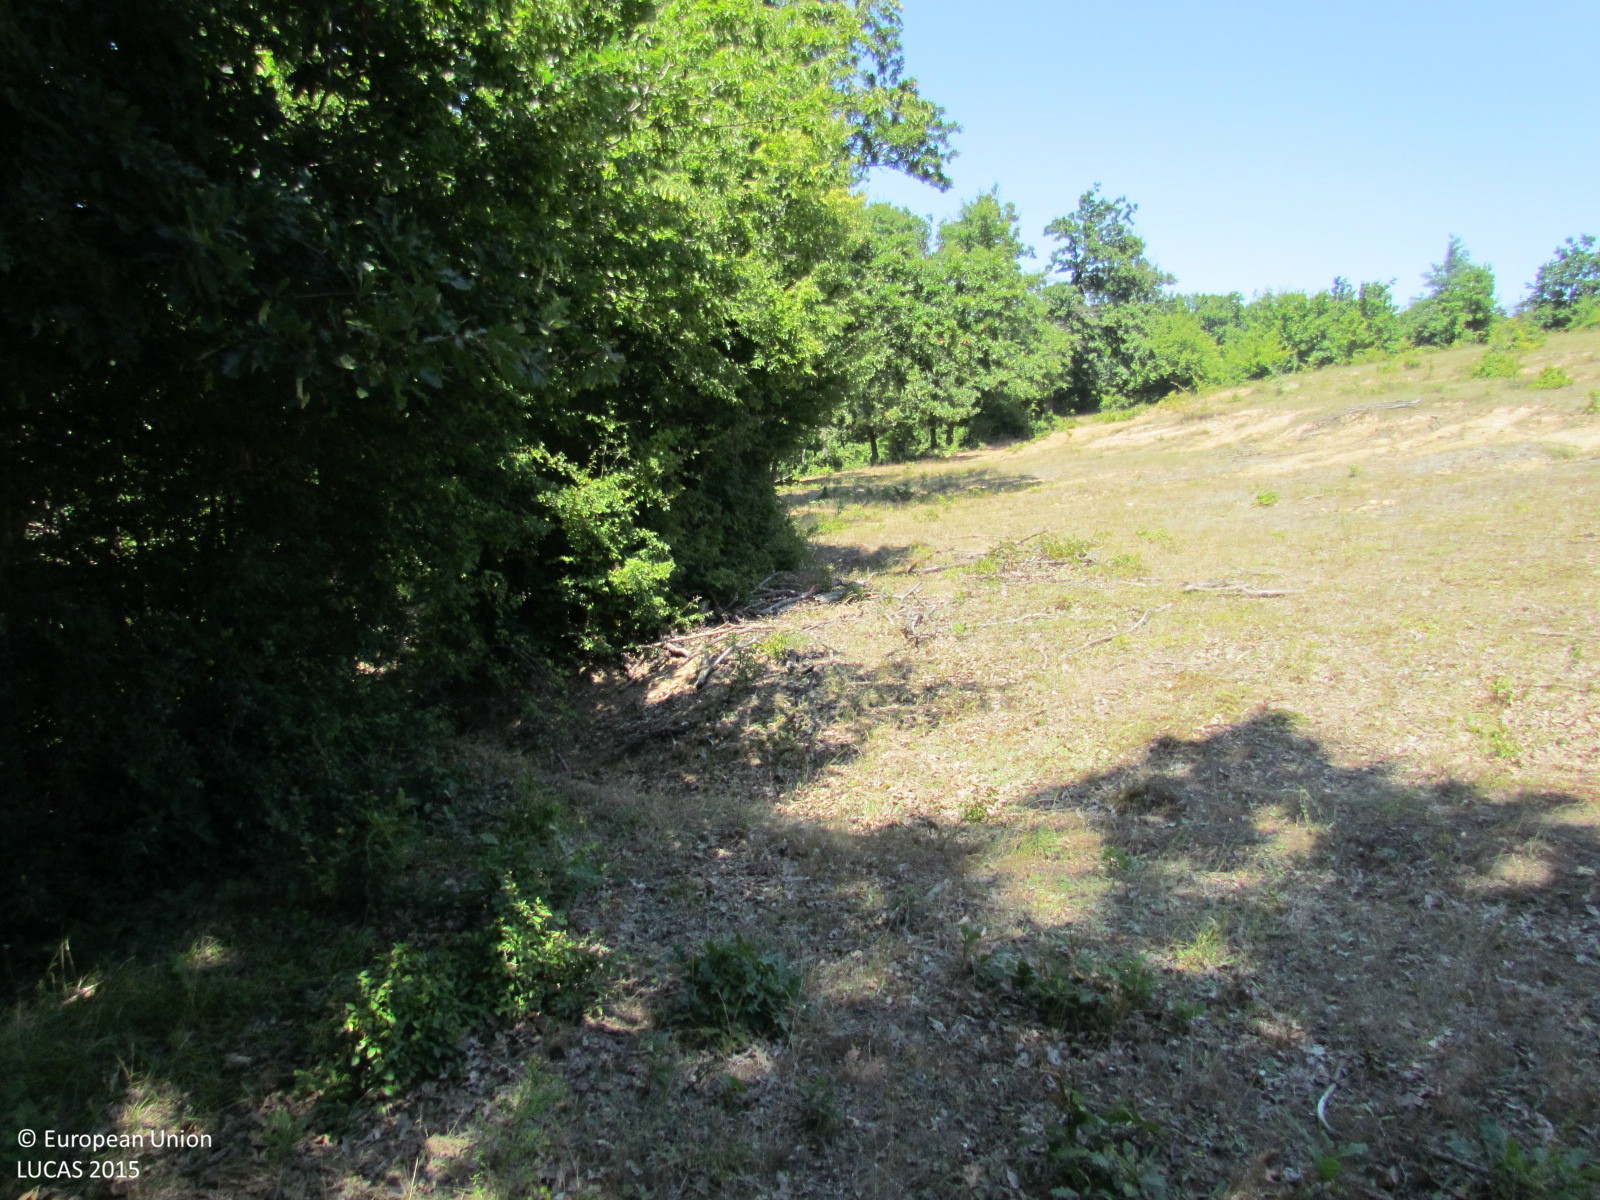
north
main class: Grassland
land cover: Grassland without tree/shrub cover
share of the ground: > 75 %
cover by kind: herbaceous plants 100 %
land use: Agriculture (excluding fallow land and kitchen gardens)
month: July
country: BG
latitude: 42.8423
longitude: 27.4339
